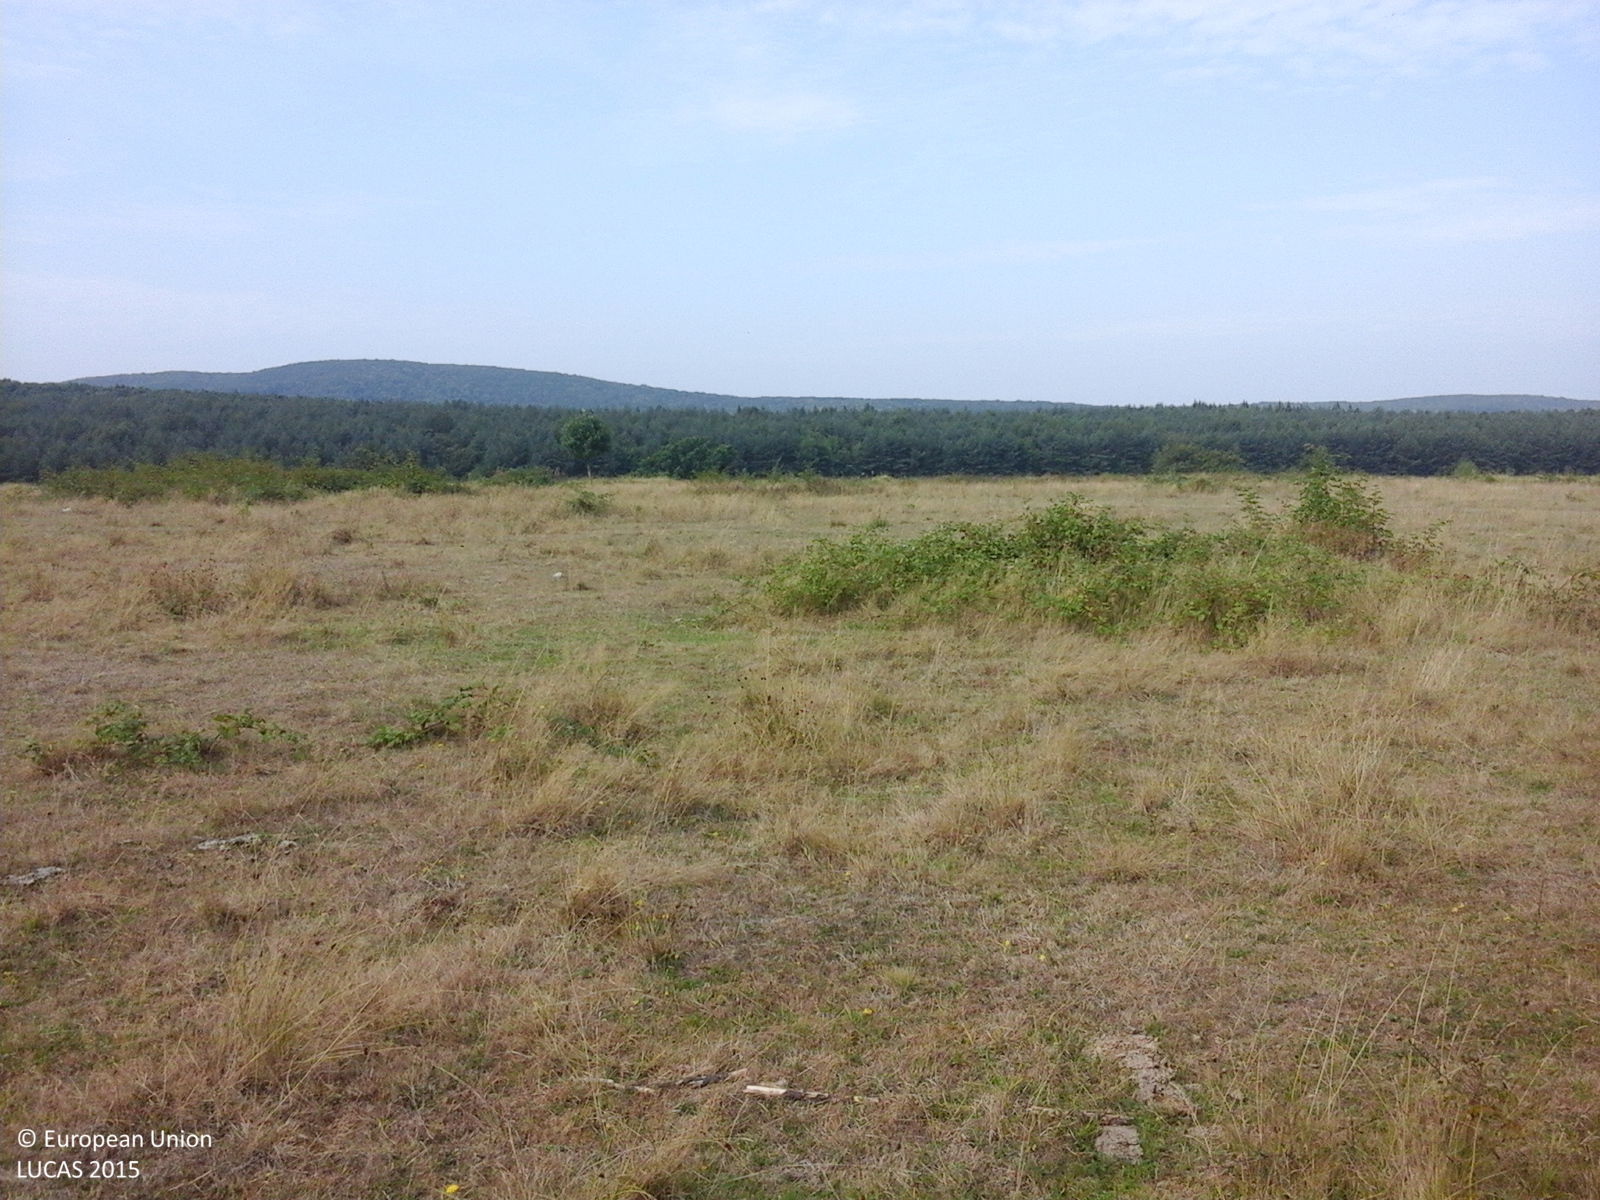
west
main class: Grassland
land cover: Grassland with sparse tree/shrub cover
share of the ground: > 75 %
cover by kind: herbaceous plants 85 %, shrubs 10 %, broadleaved forest trees 5 %
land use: Agriculture (excluding fallow land and kitchen gardens)
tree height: < 5 m
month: August
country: RO
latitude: 46.3601
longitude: 22.1985
